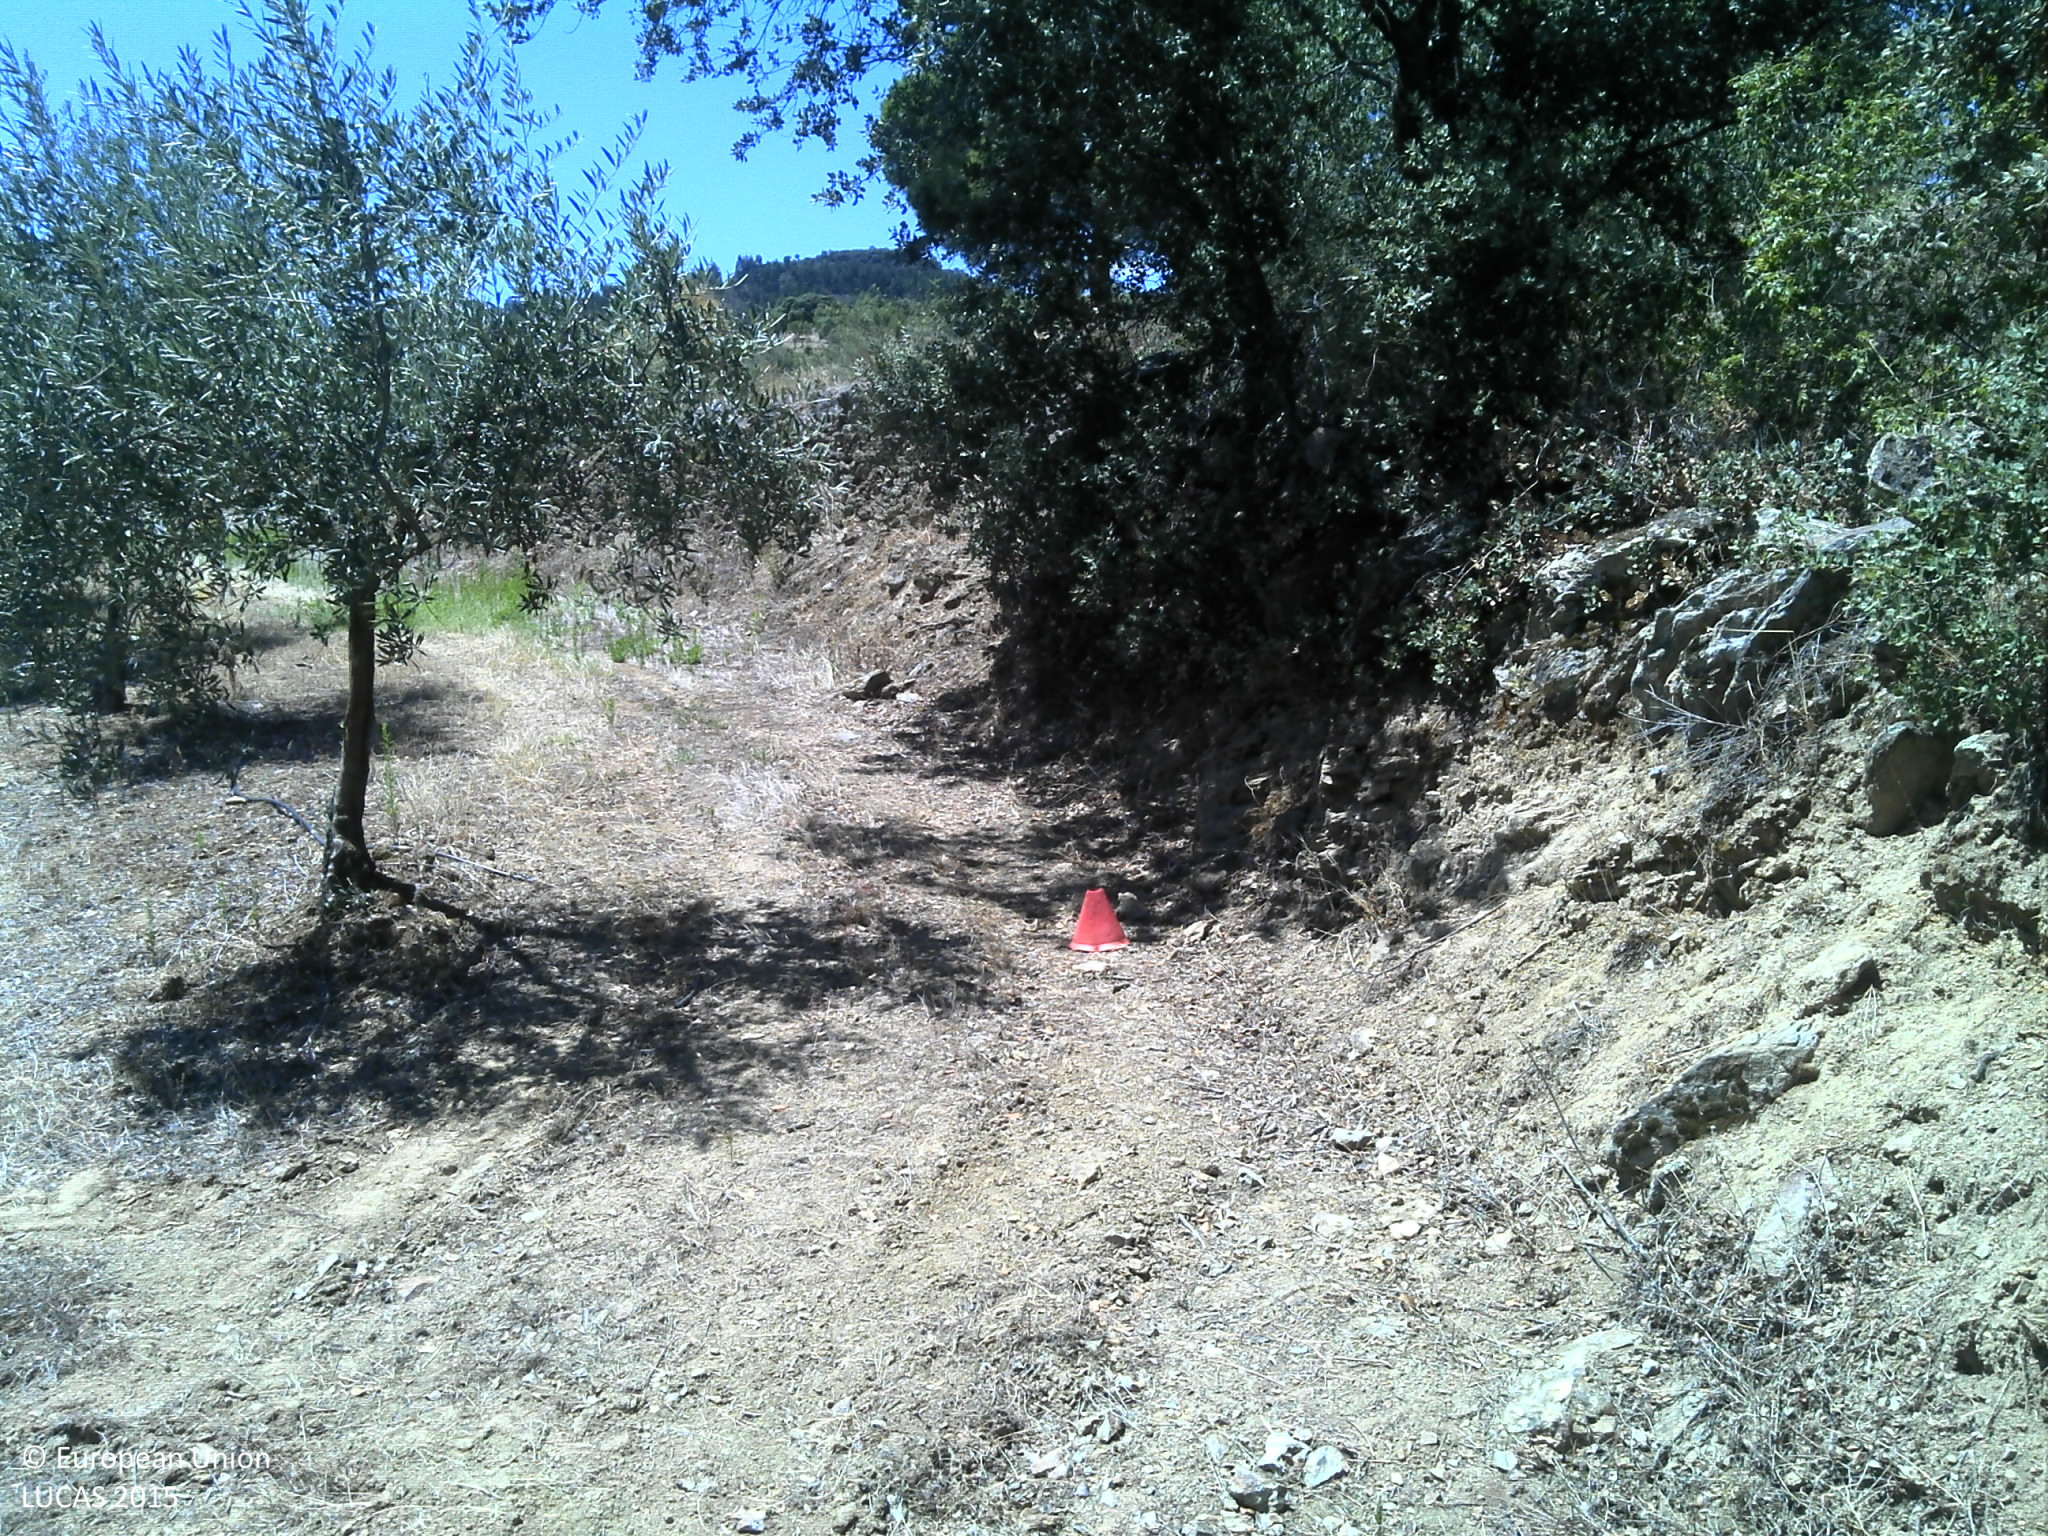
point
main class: Cropland
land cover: Olive groves
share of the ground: 10 - 25 %
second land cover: Spontaneously vegetated surfaces
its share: 25 - 50 %
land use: Agriculture (excluding fallow land and kitchen gardens)
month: July
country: PT
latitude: 41.3571
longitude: -7.0759
